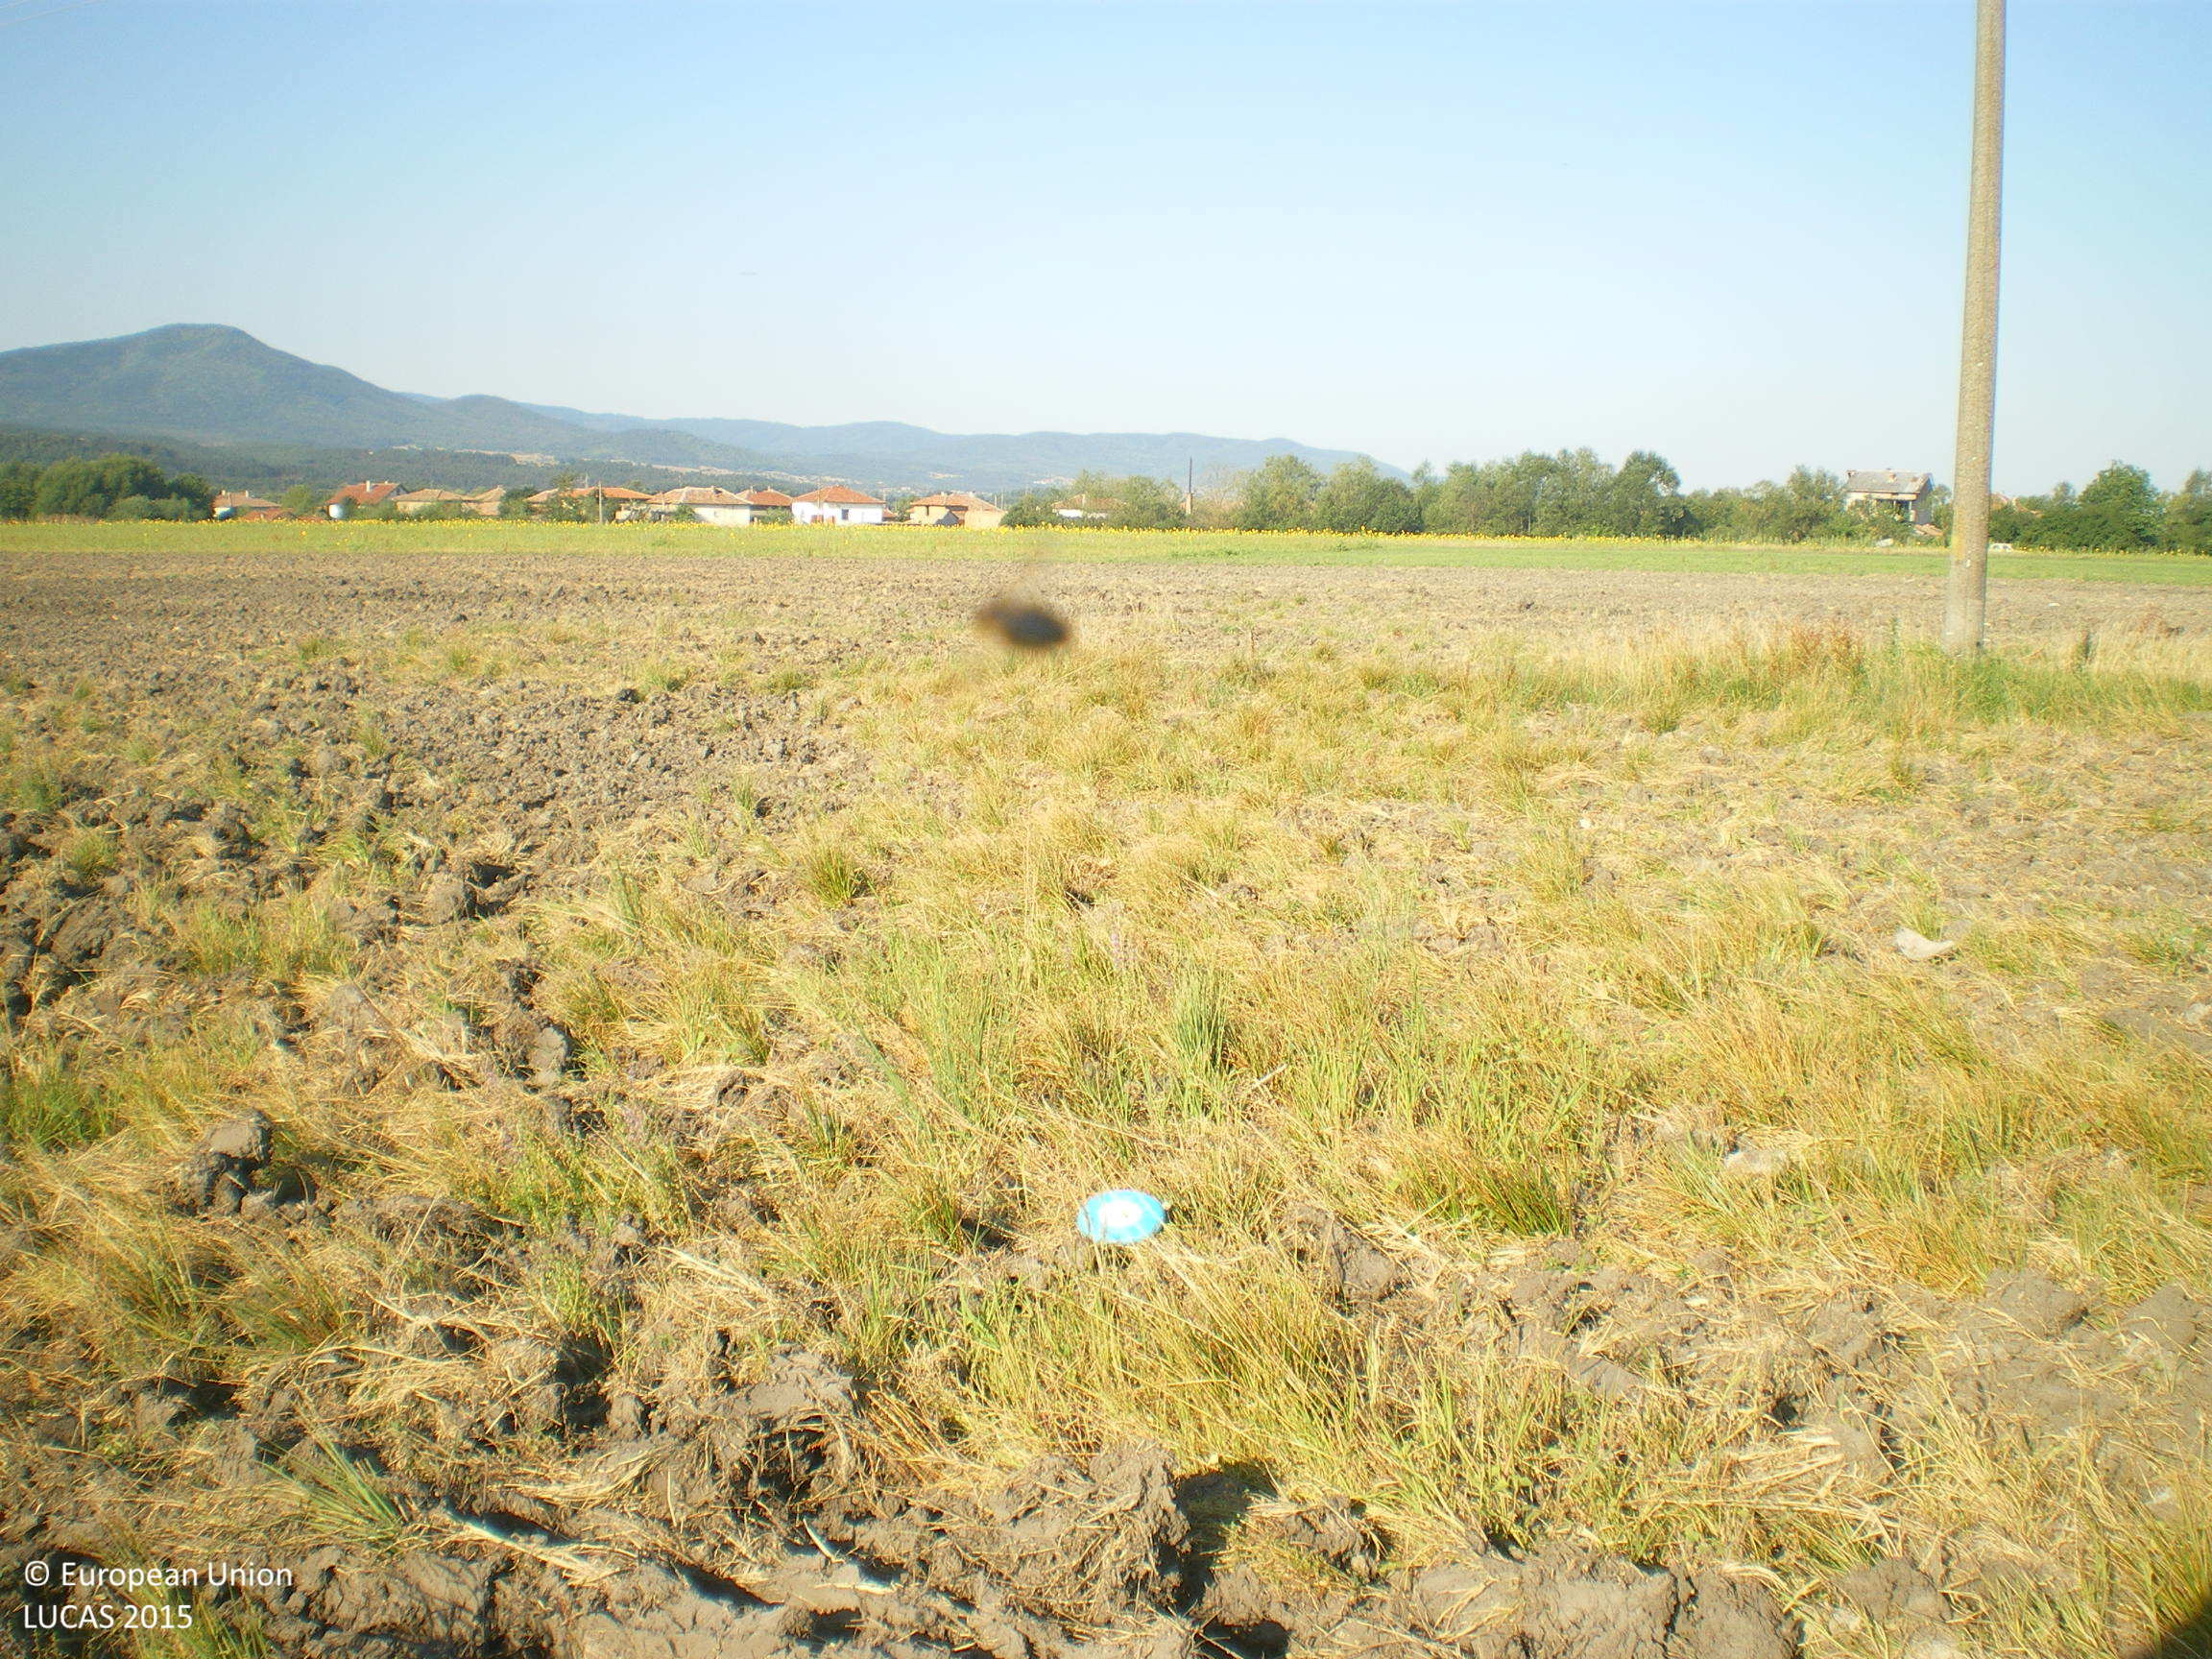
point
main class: Grassland
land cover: Spontaneously vegetated surfaces
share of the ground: 50 - 75 %
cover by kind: herbaceous plants 50 %, unconsolidated bare surface 50 %
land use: Agriculture (excluding fallow land and kitchen gardens)
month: July
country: BG
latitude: 42.6223
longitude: 25.1712
